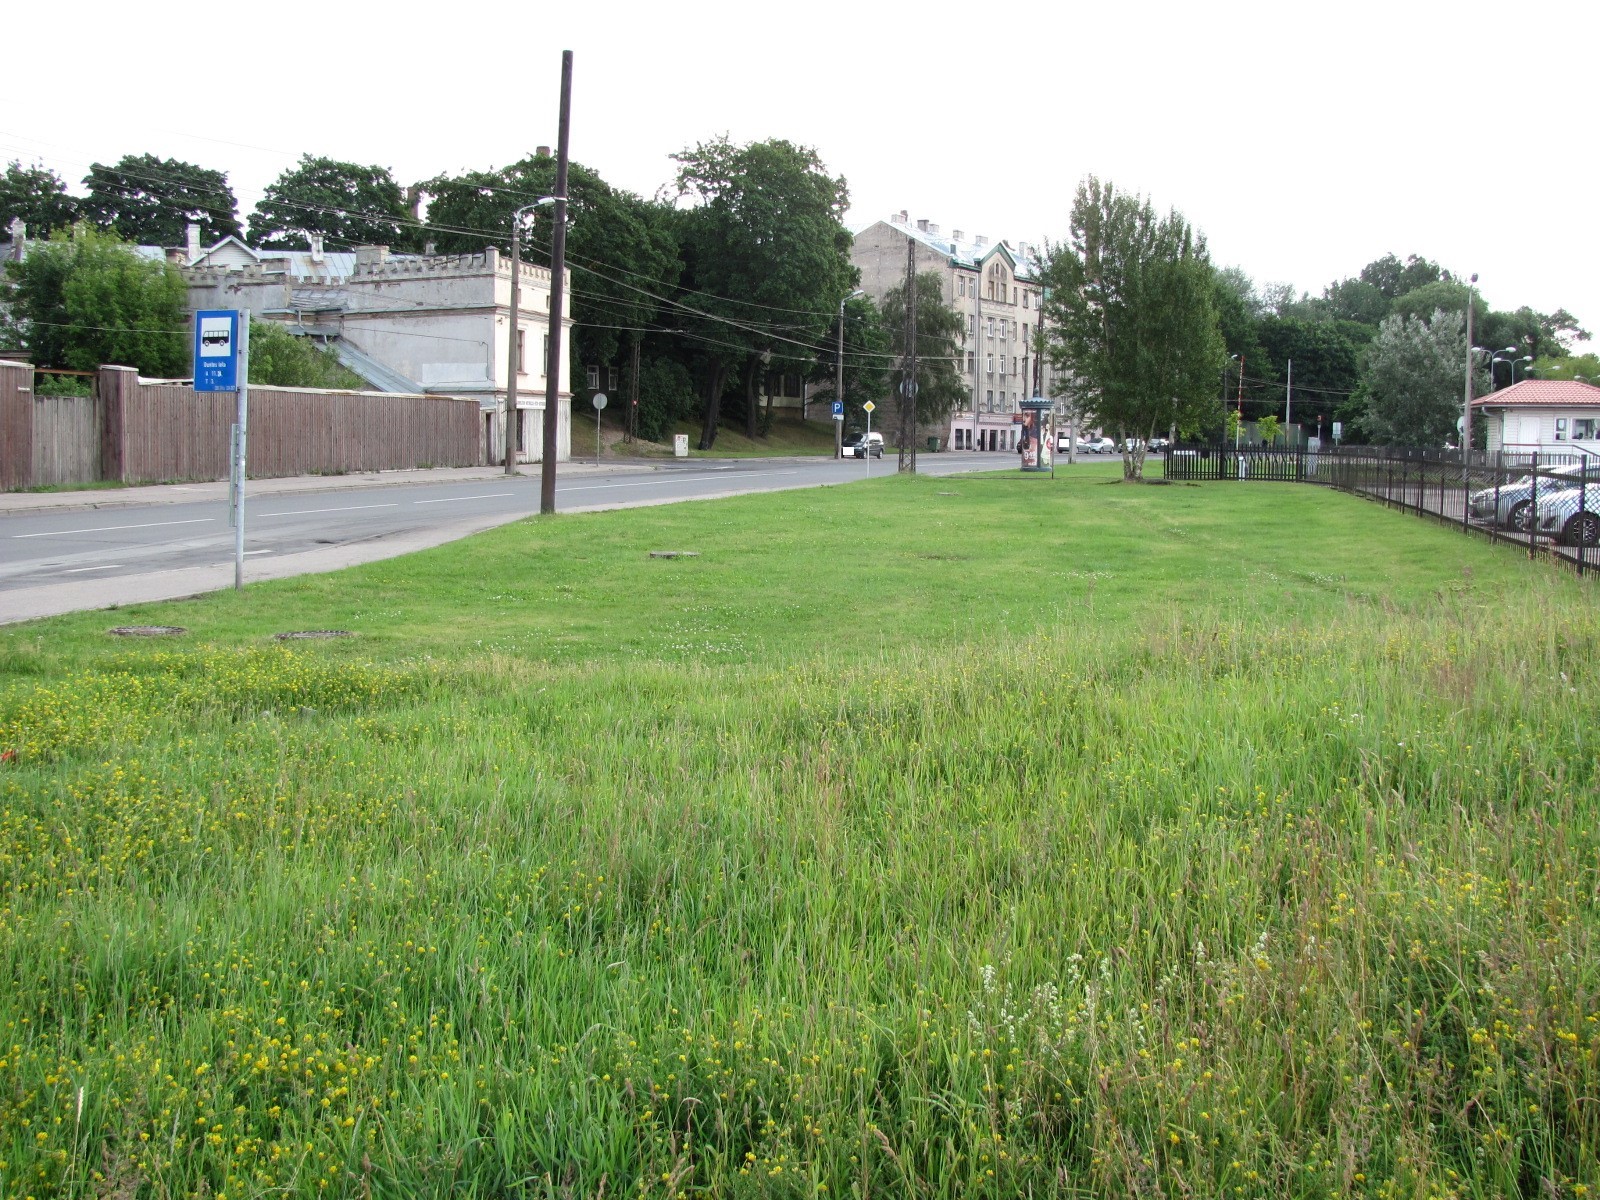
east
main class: Grassland
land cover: Grassland without tree/shrub cover
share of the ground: > 75 %
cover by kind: herbaceous plants 100 %
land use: Community services
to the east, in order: Grassland without tree/shrub cover; Artificial constructions in urban areas
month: July
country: LV
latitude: 56.9923
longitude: 24.1253
